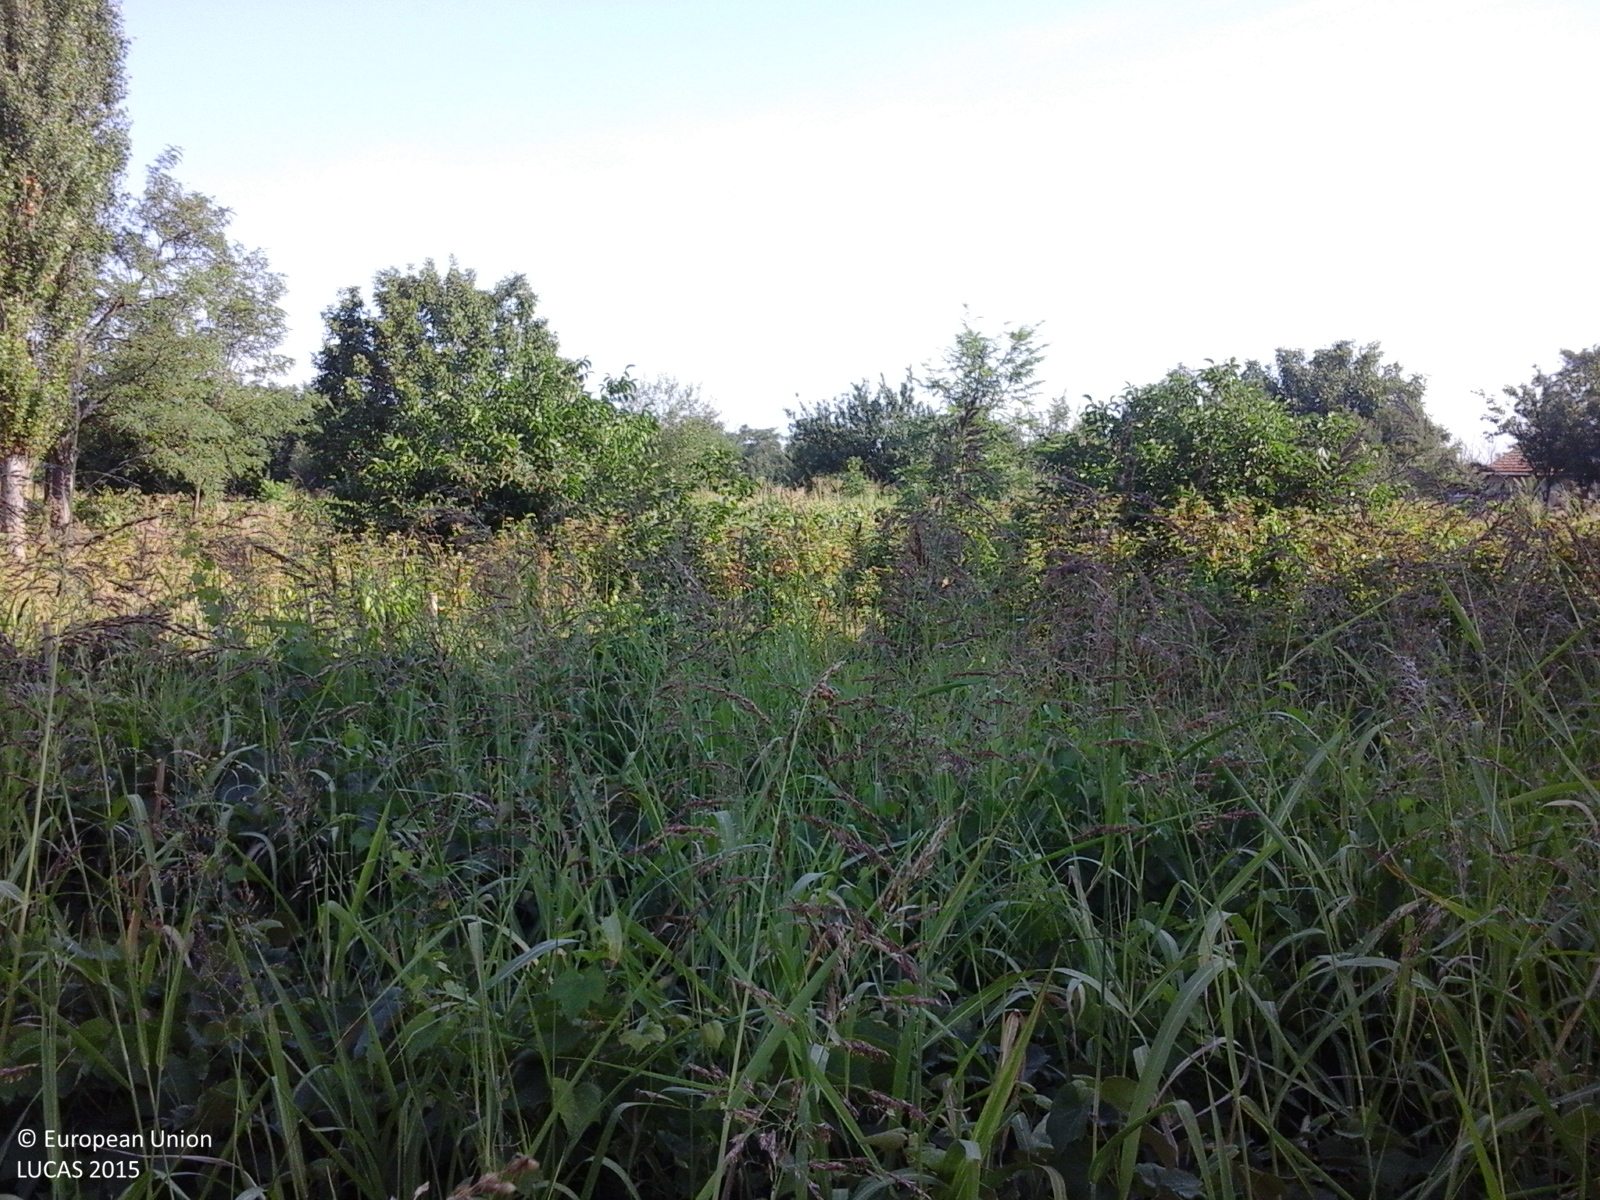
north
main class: Cropland
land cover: Vineyards
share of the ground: 50 - 75 %
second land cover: Grassland without tree/shrub cover
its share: > 75 %
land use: Agriculture (excluding fallow land and kitchen gardens)
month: August
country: RO
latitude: 44.0928
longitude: 23.2990
